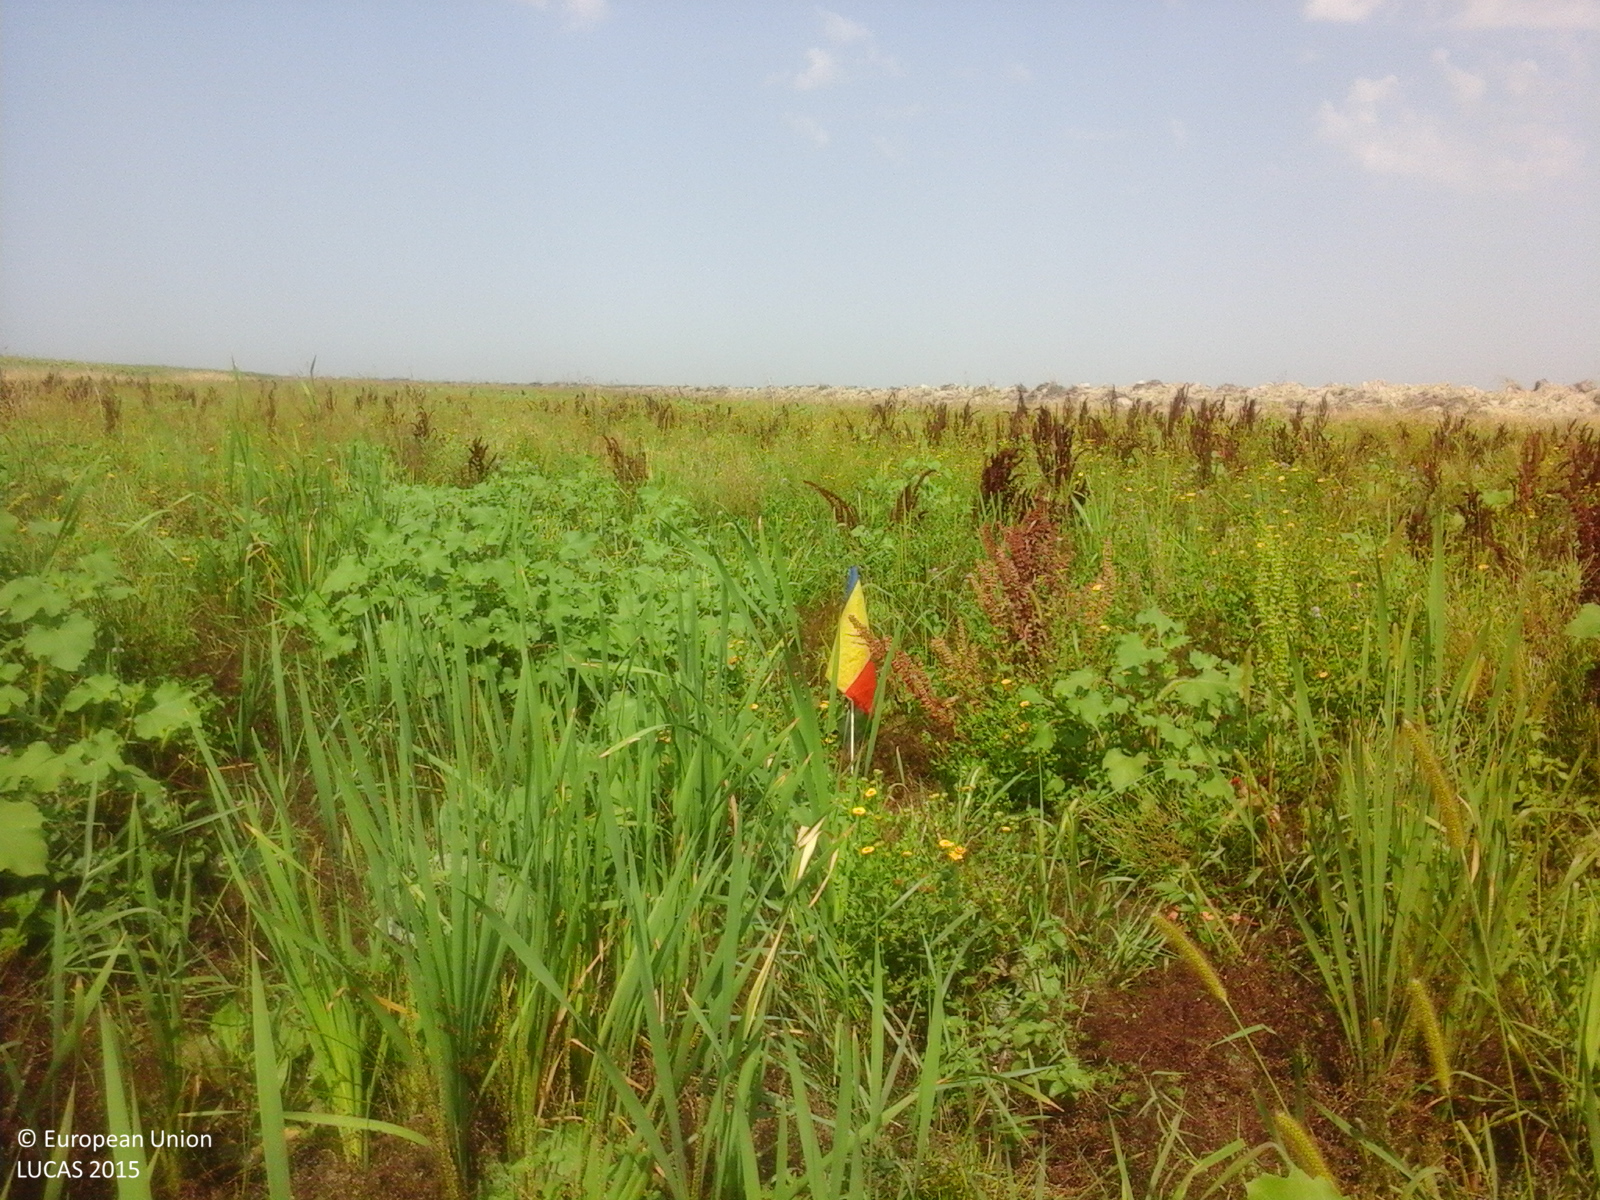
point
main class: Grassland
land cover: Spontaneously vegetated surfaces
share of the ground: > 75 %
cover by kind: herbaceous plants 100 %
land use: Agriculture (excluding fallow land and kitchen gardens)
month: August
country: RO
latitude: 43.8495
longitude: 23.6212
